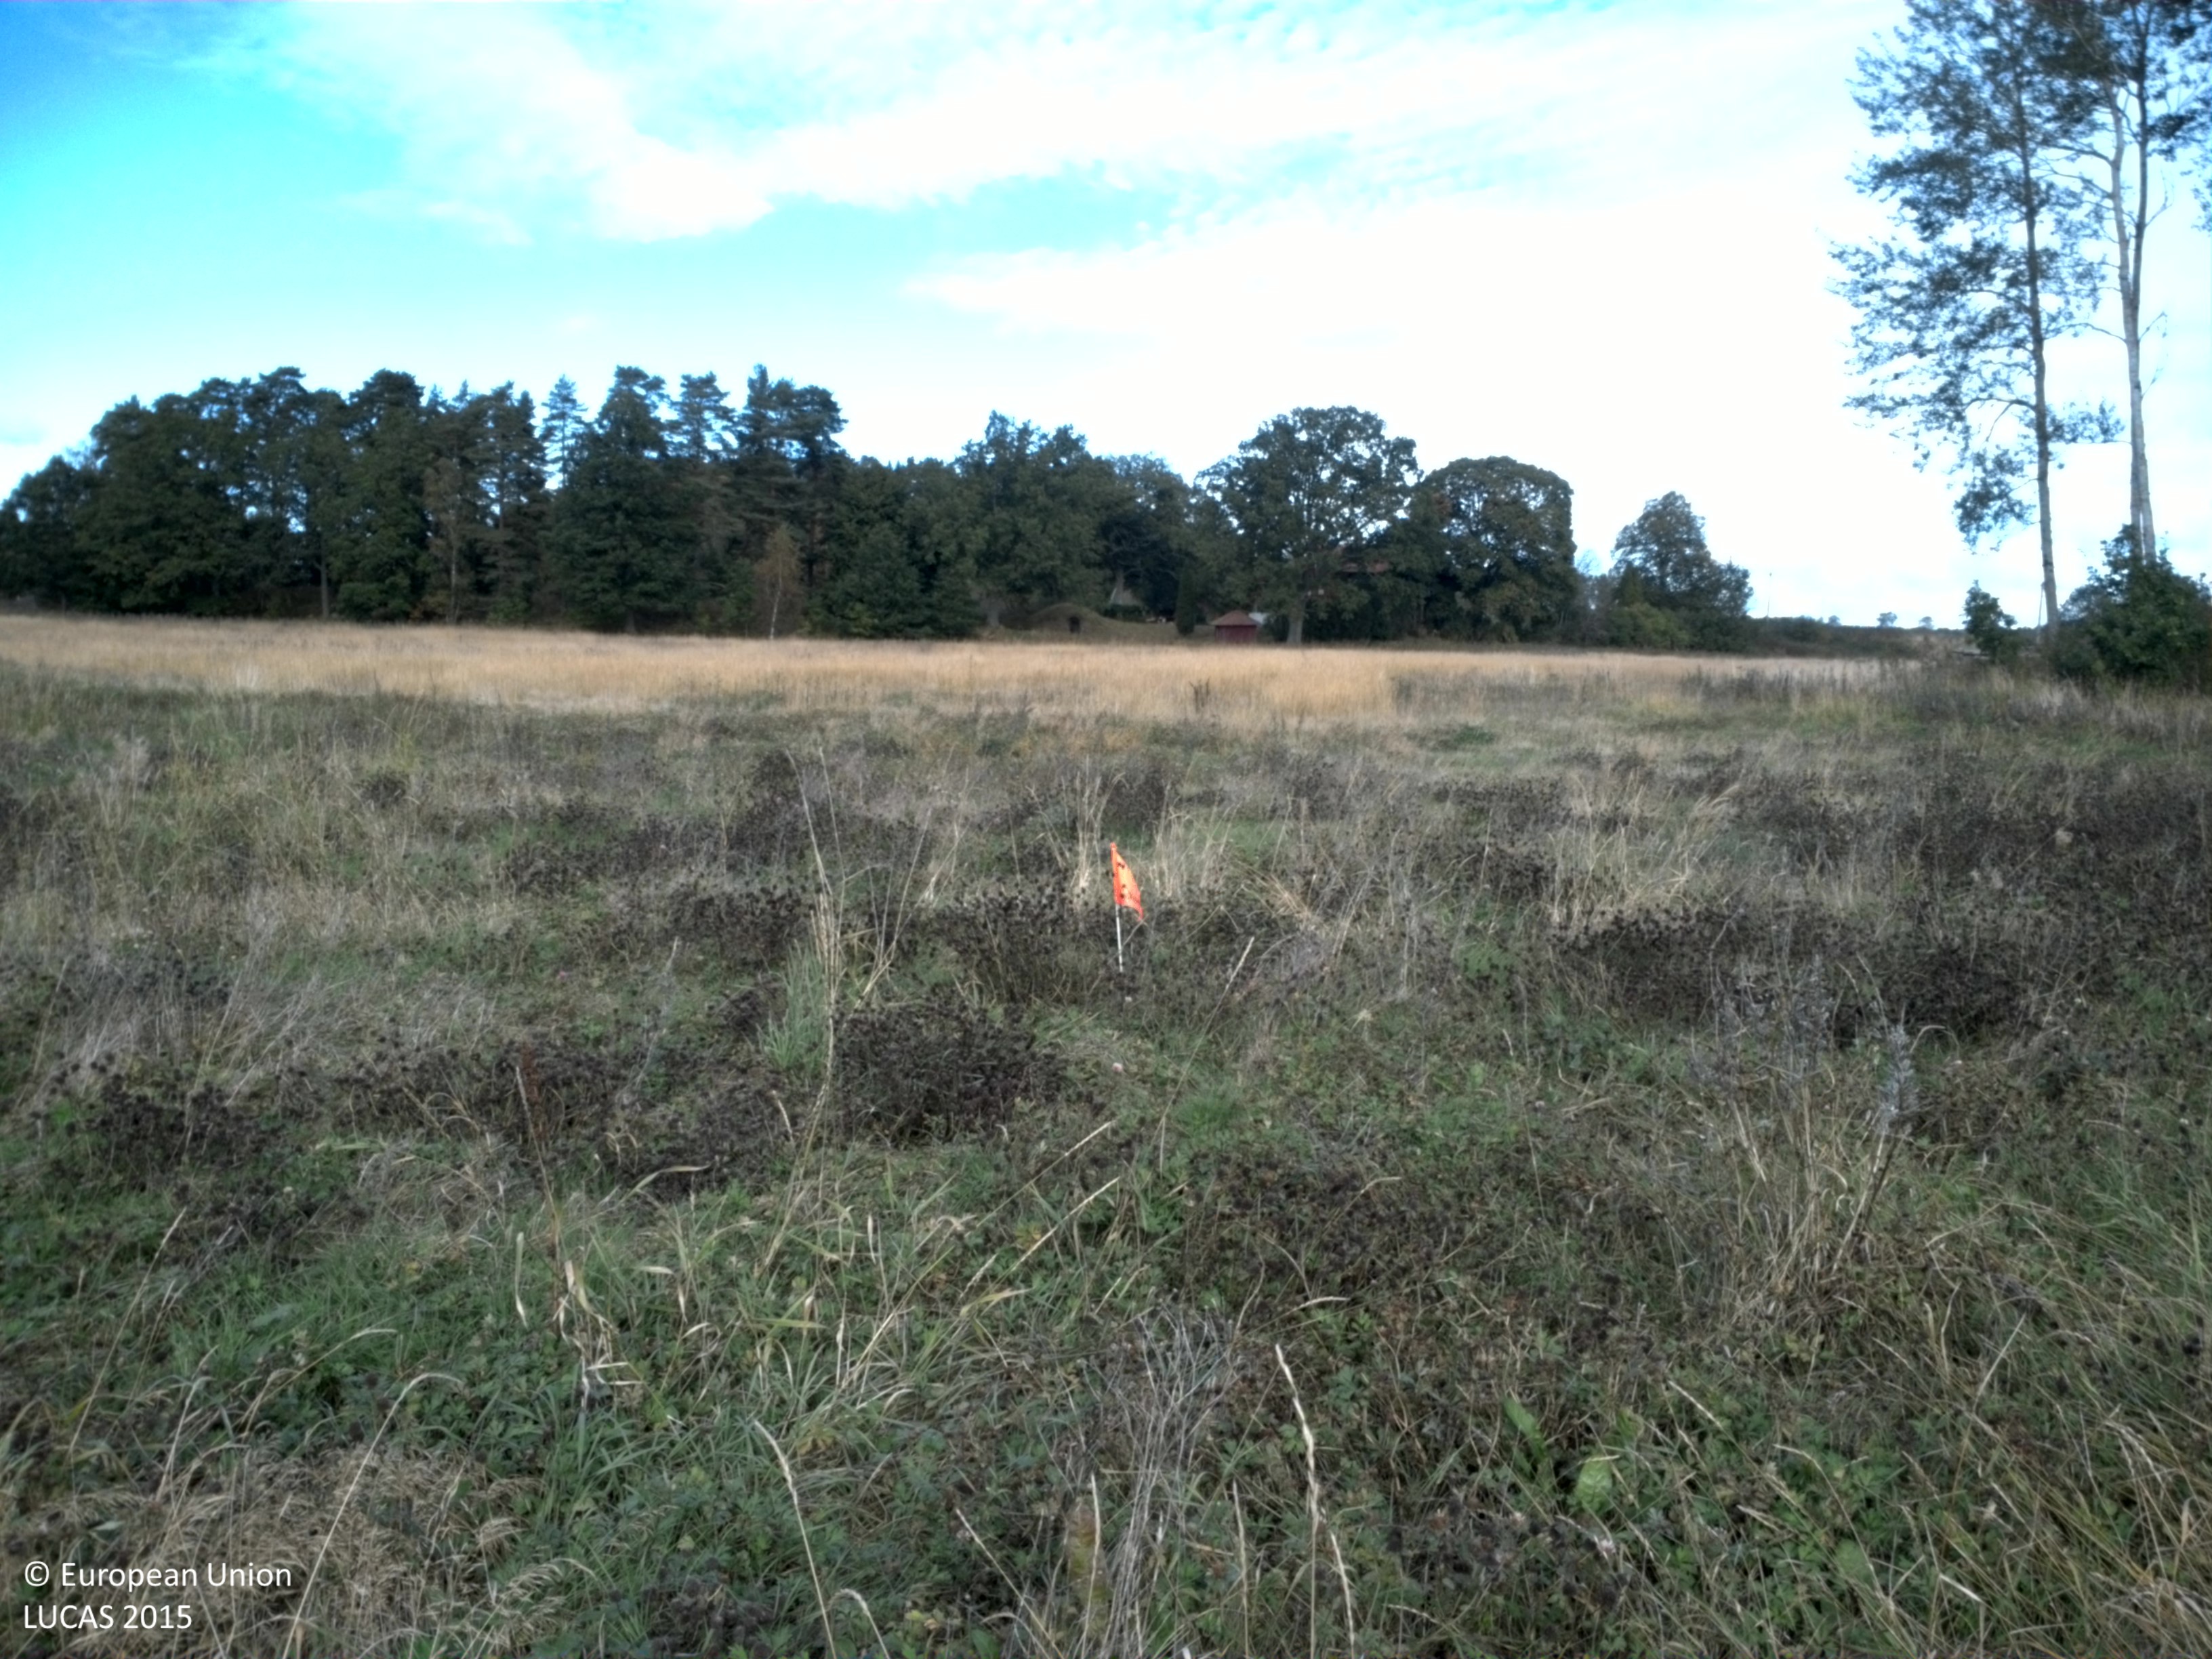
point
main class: Grassland
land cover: Spontaneously vegetated surfaces
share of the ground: > 75 %
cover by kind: herbaceous plants 100 %
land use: Fallow land
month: September
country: SE
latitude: 59.0929
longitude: 14.1289
